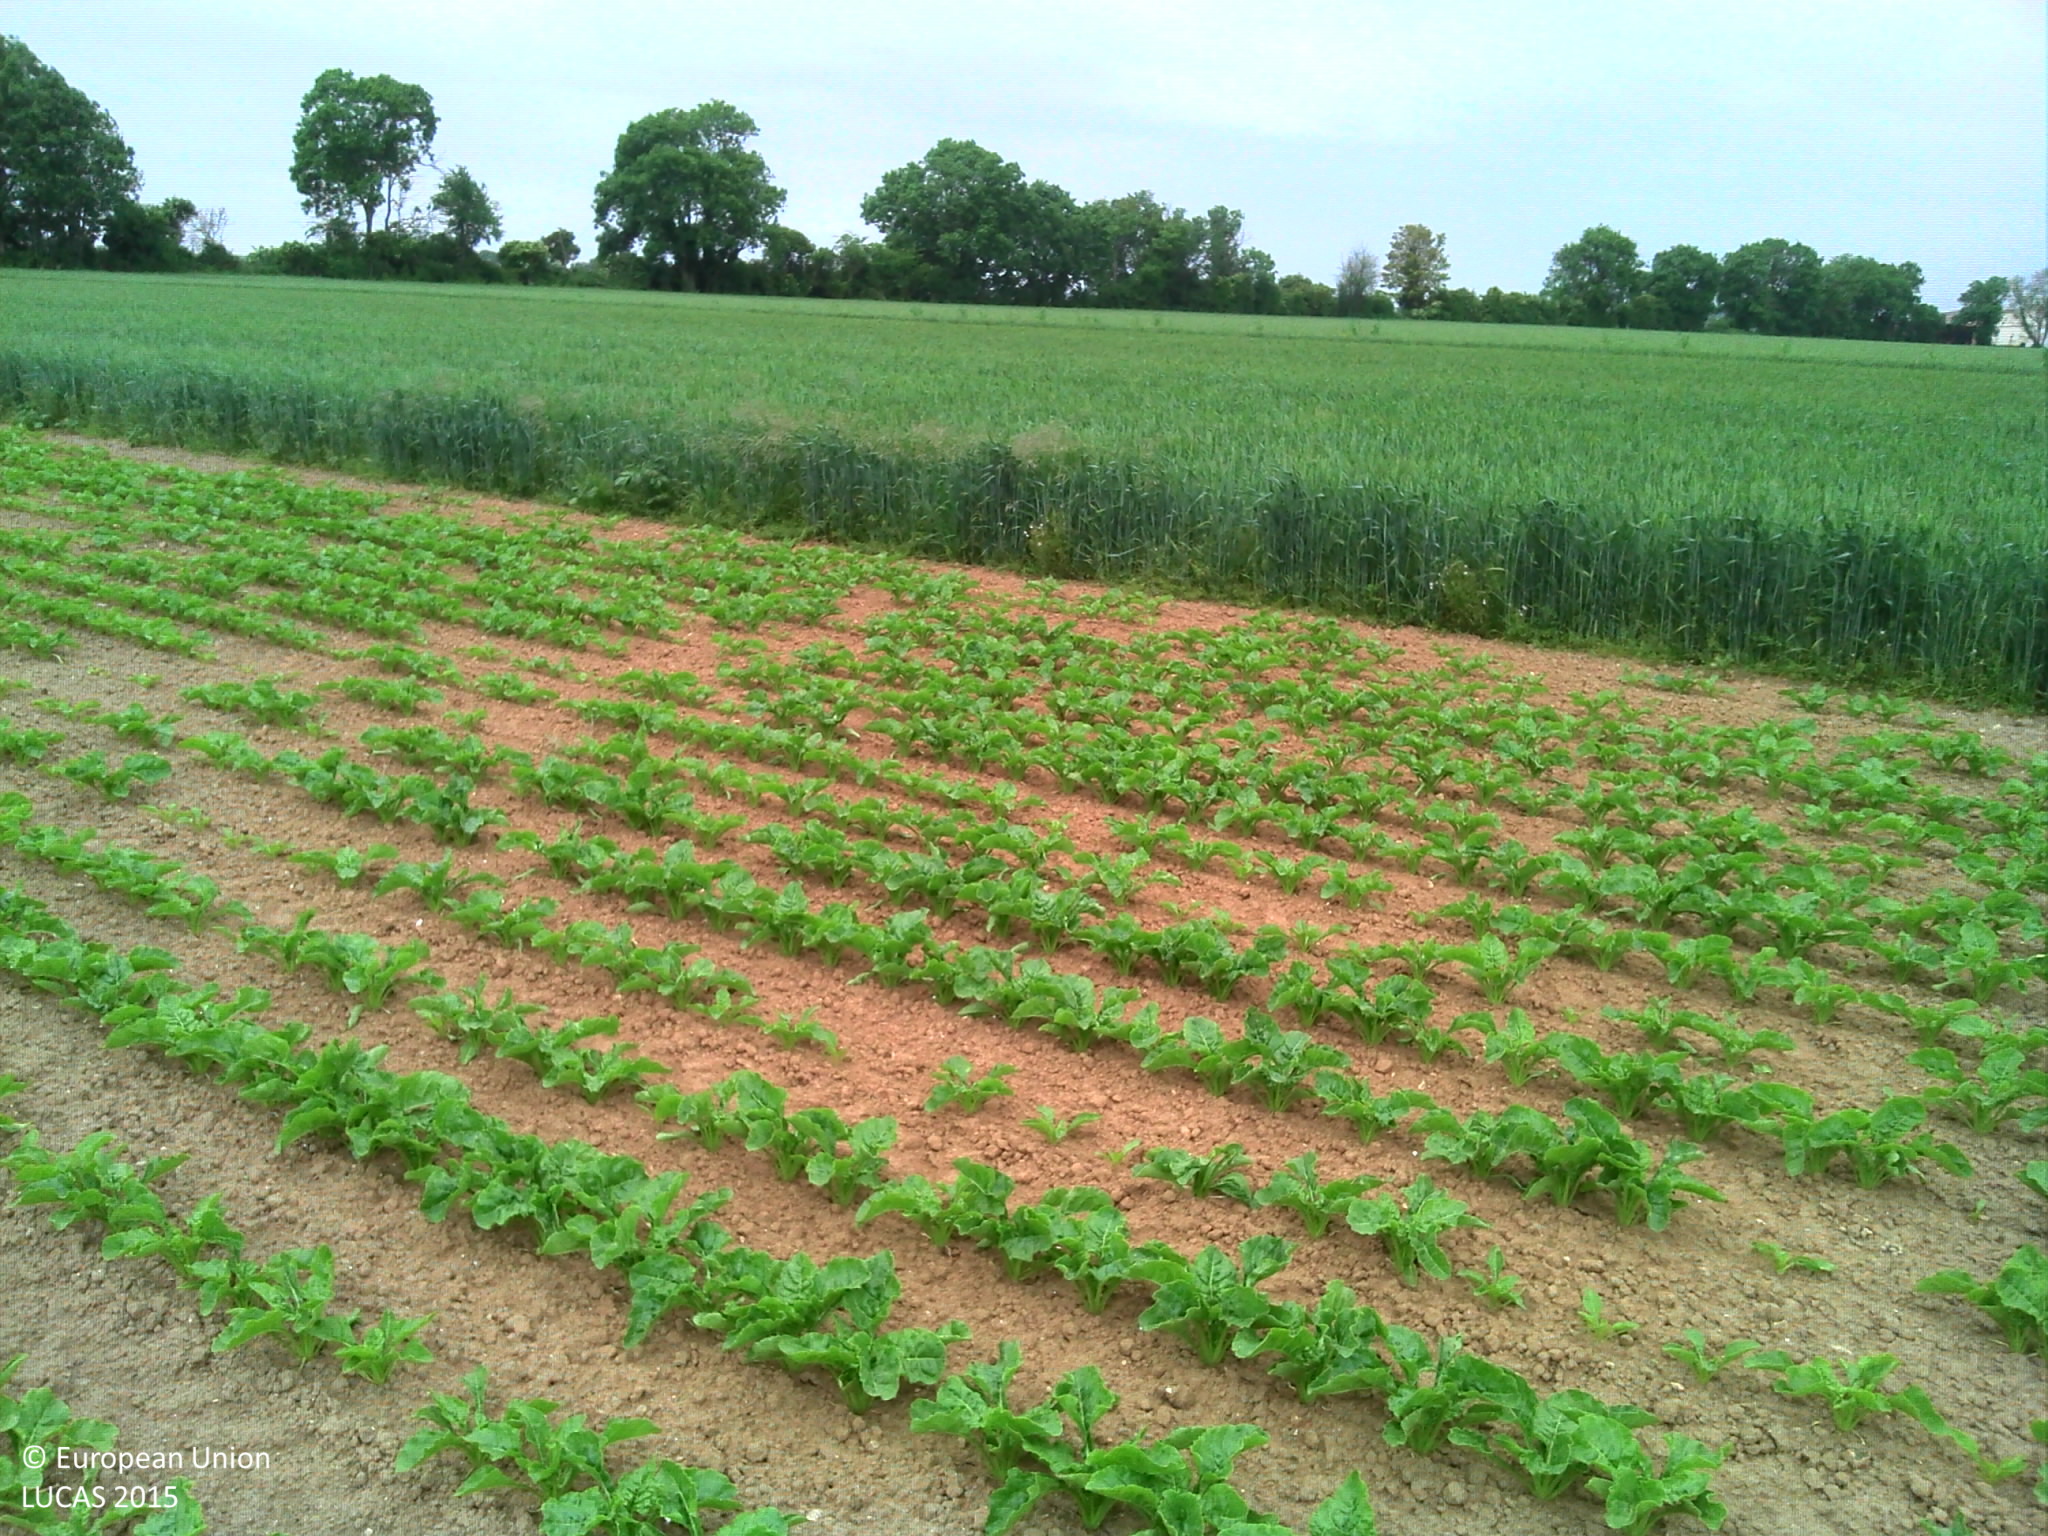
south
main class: Cropland
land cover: Sugar beet
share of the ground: 25 - 50 %
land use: Agriculture (excluding fallow land and kitchen gardens)
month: May
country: FR
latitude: 49.2963
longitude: -0.3341
